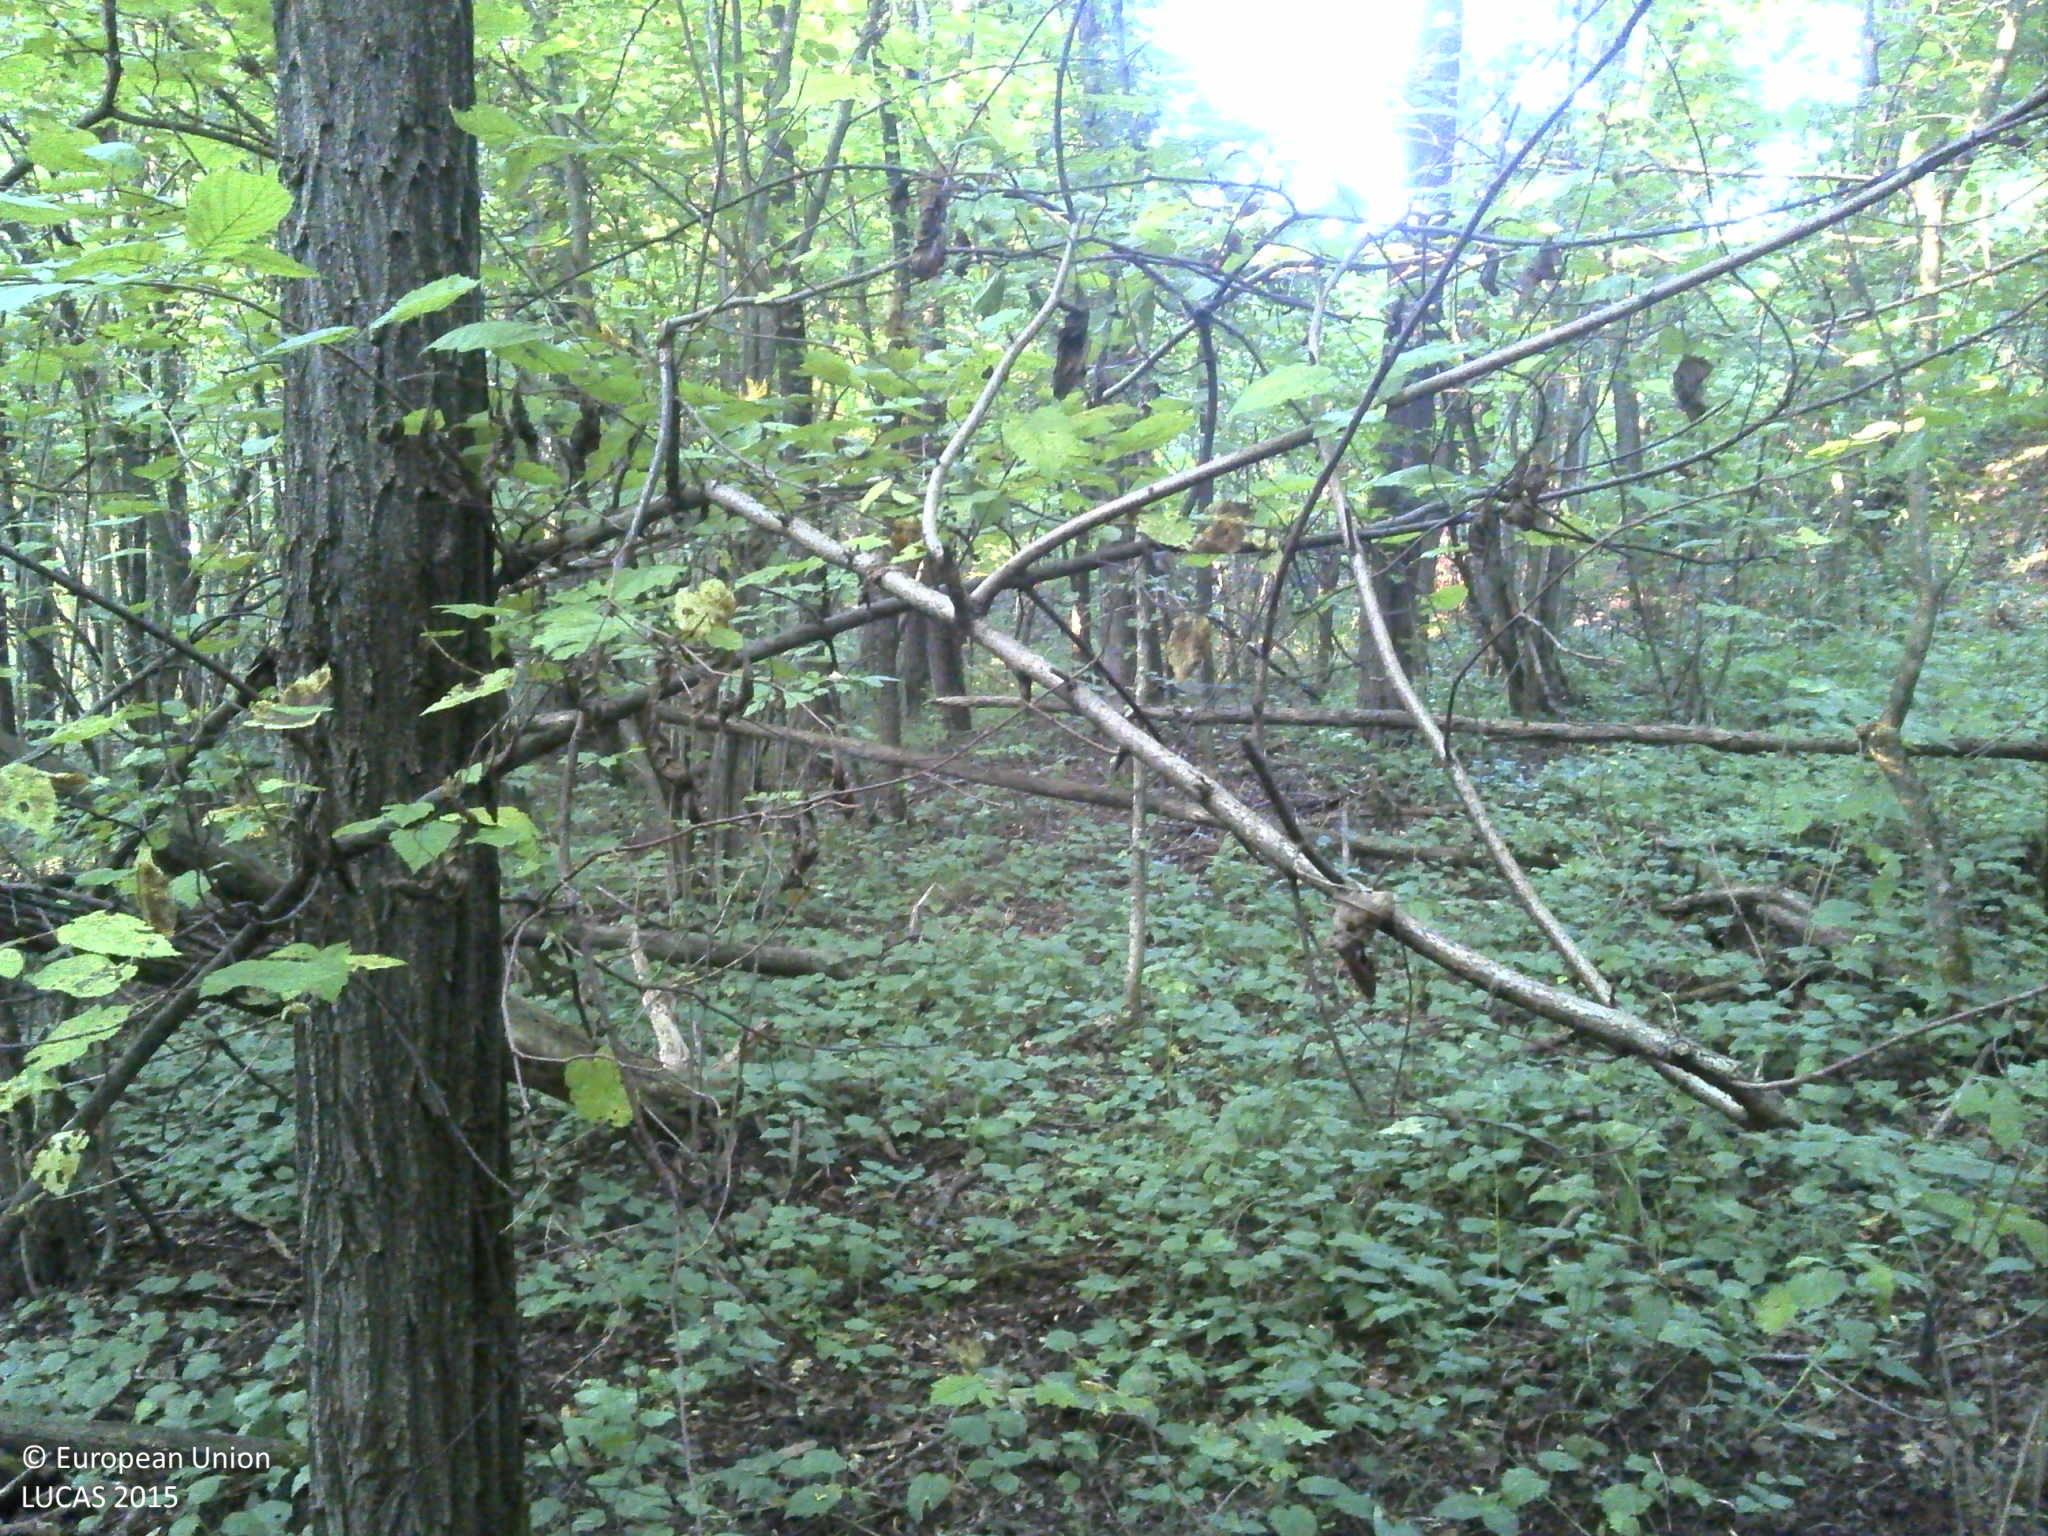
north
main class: Woodland
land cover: Broadleaved woodland
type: acidophilous oak and oak-birch forest
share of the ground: > 75 %
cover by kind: broadleaved forest trees 100 %
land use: Forestry
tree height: > 5 m
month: August
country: HR
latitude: 45.3575
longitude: 16.2138
